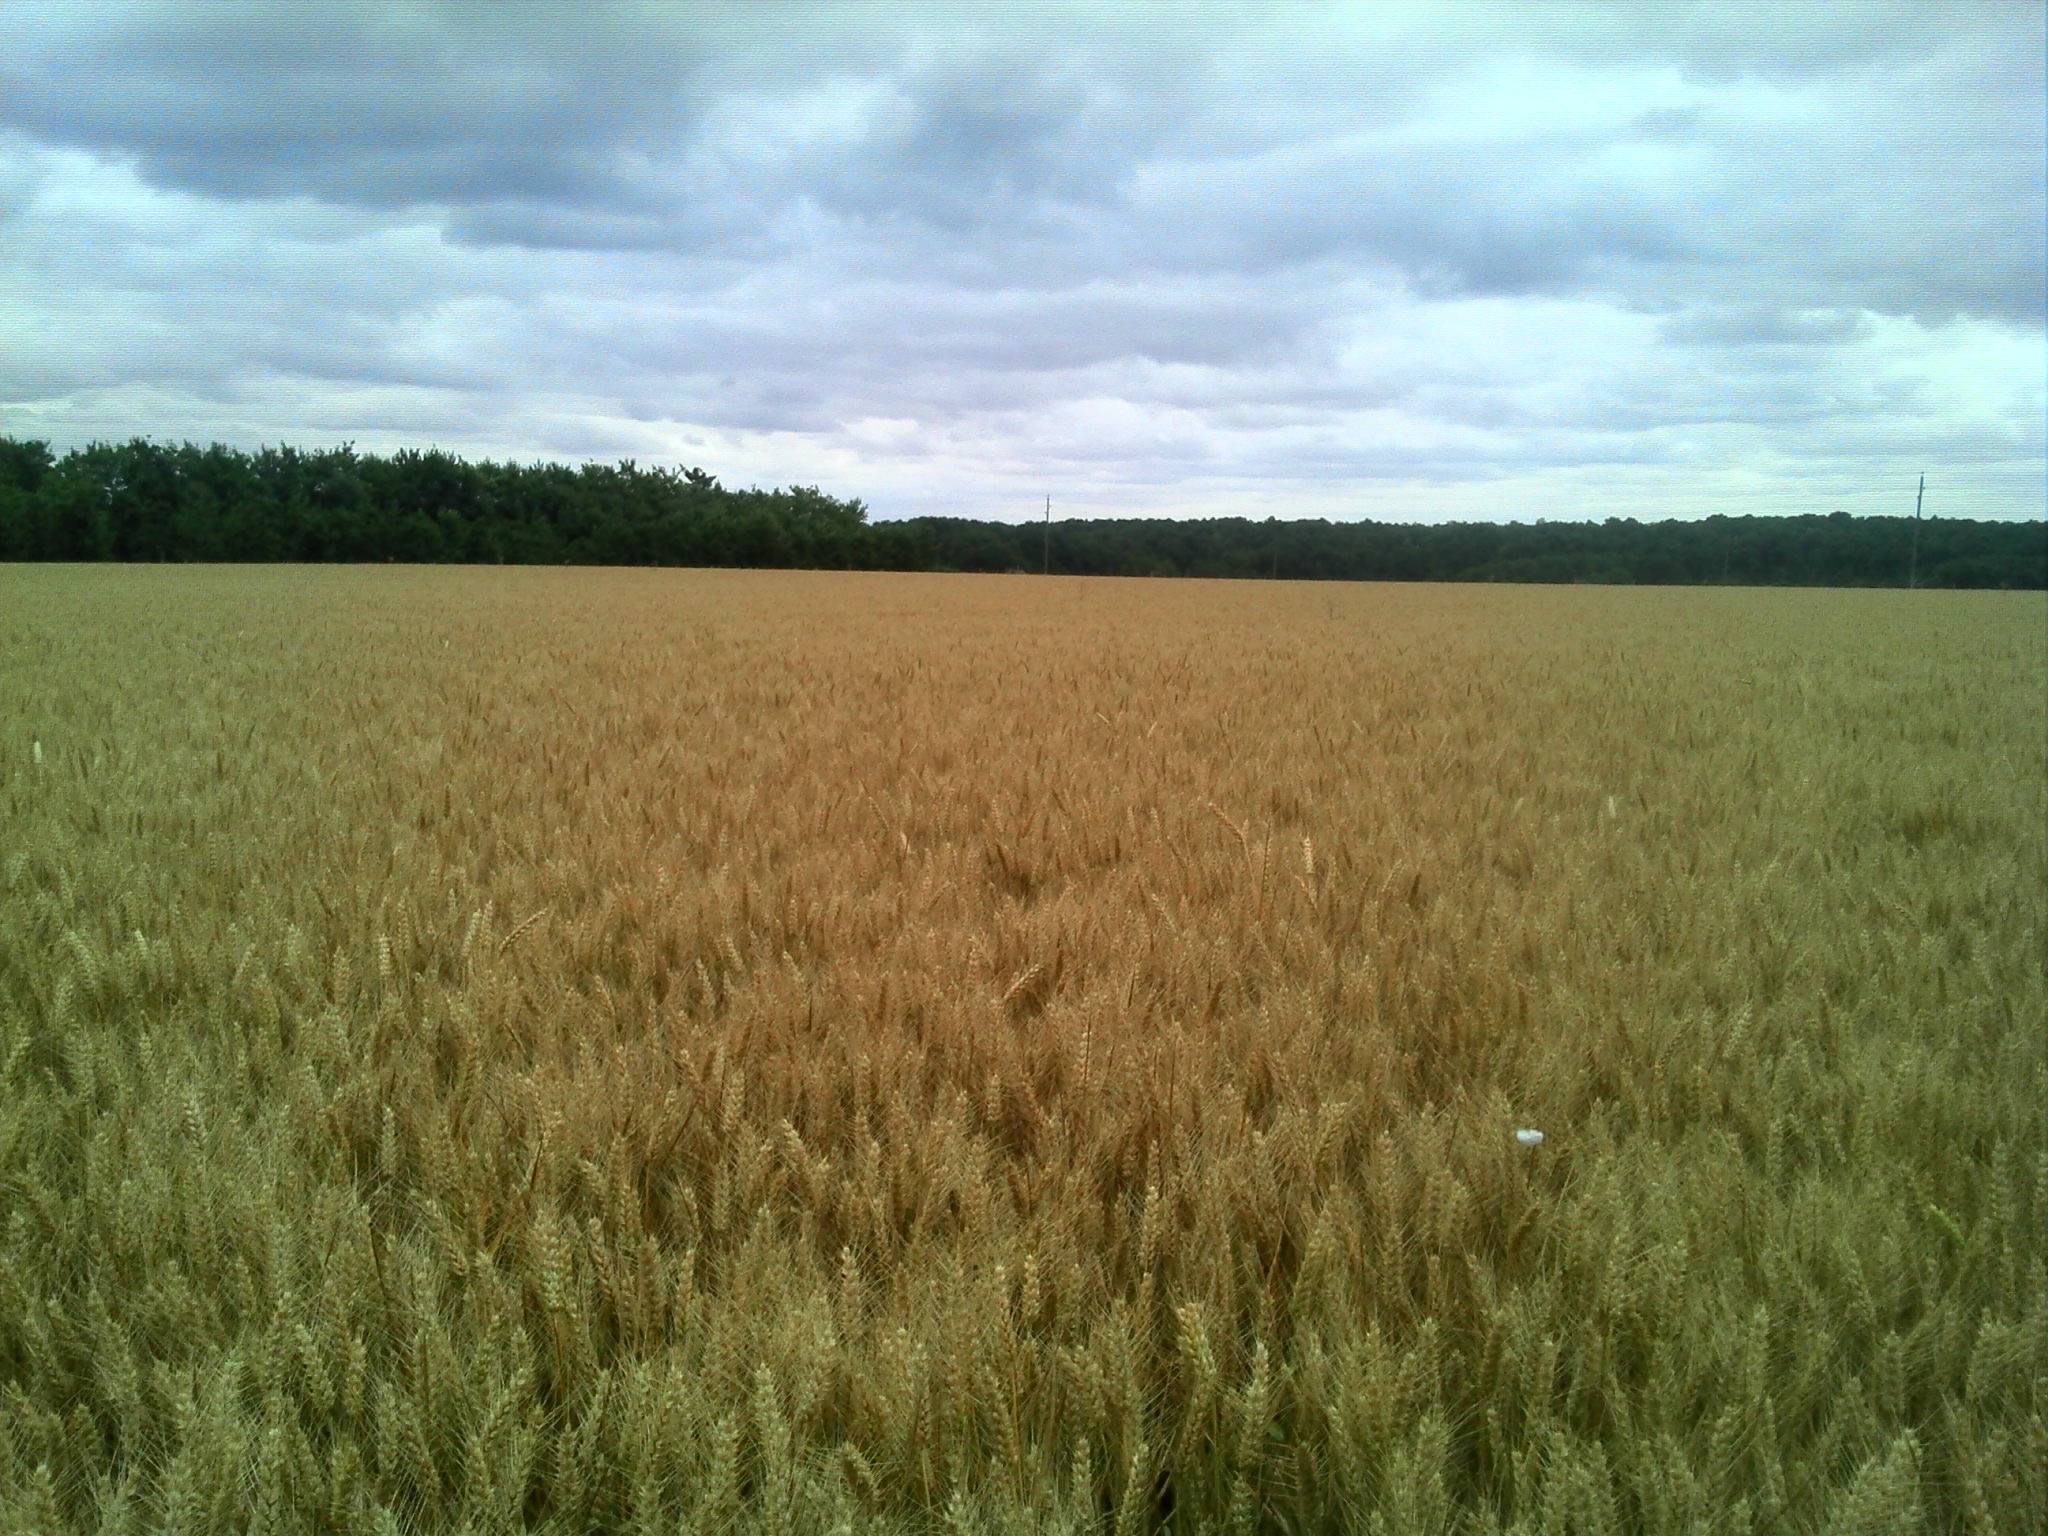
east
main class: Cropland
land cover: Common wheat
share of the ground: > 75 %
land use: Agriculture (excluding fallow land and kitchen gardens)
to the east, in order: Common wheat; Electric lines; Grass margins; Tracks; Grass margins; Electric lines; Common wheat
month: July
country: FR
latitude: 49.0085
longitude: 0.7206
